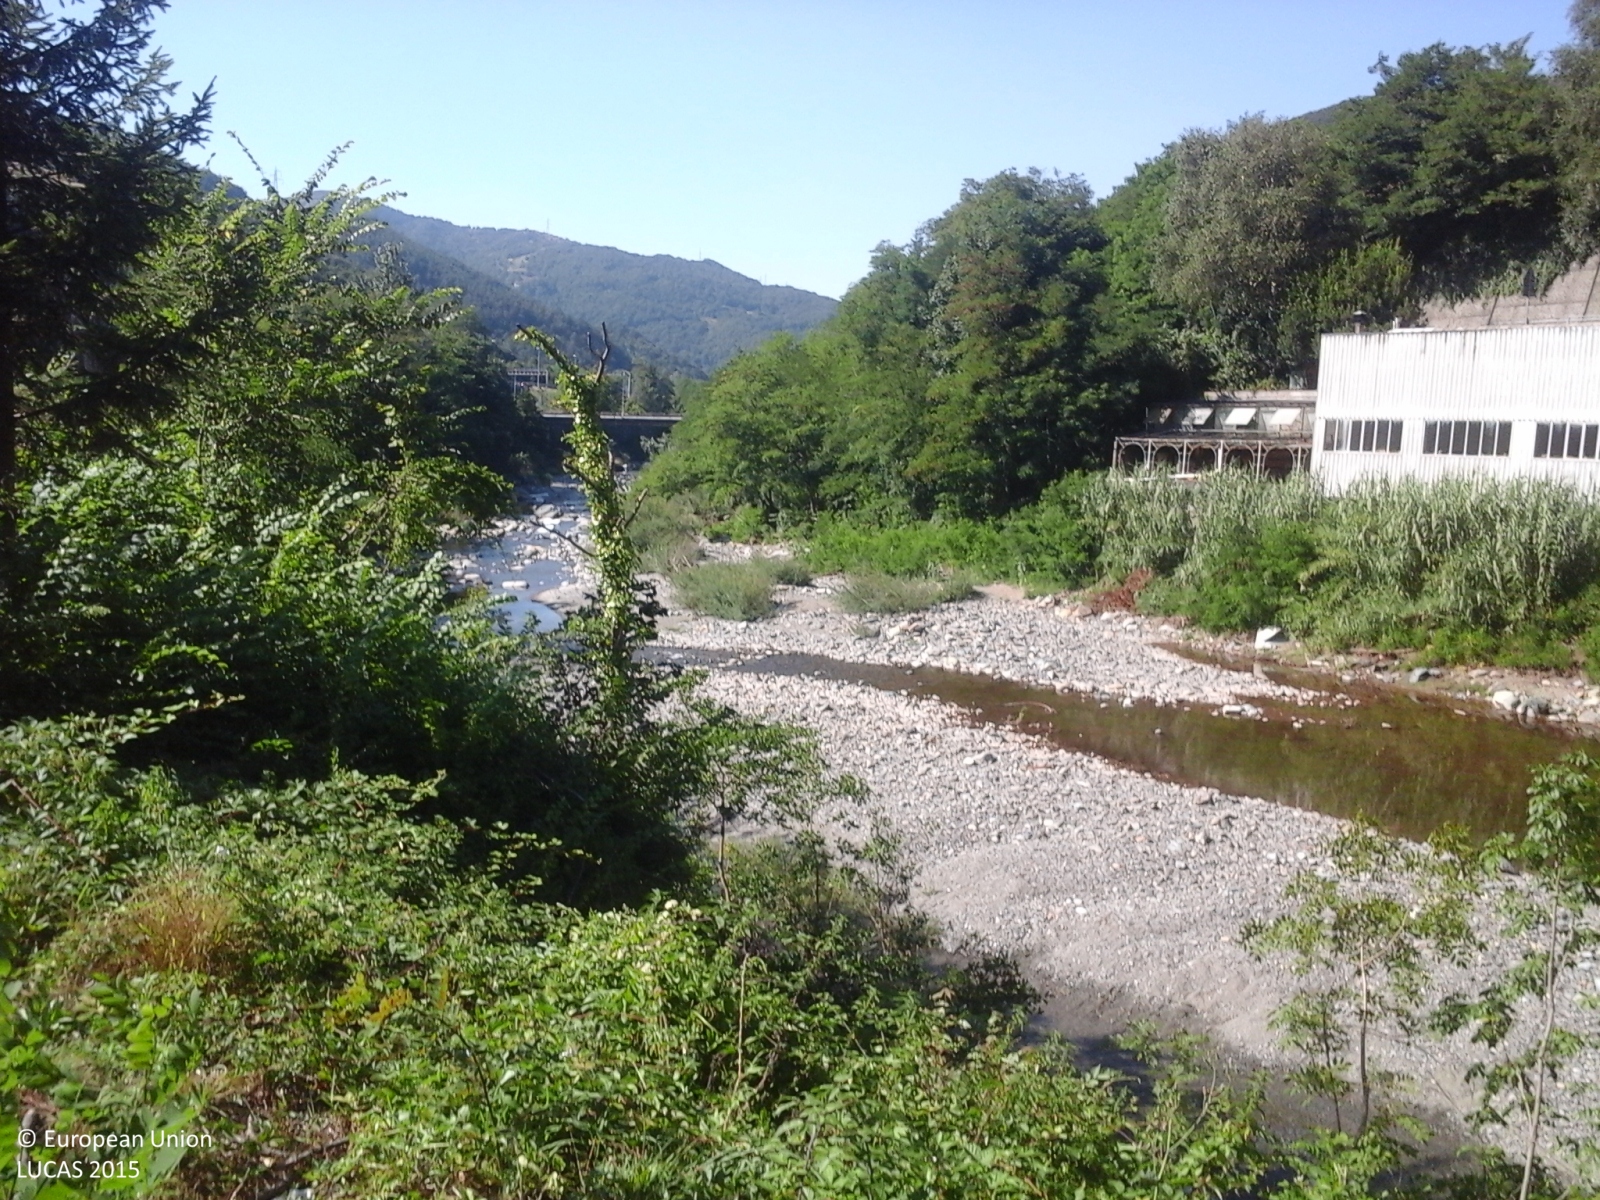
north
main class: Grassland
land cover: Grassland with sparse tree/shrub cover
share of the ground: > 75 %
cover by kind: herbaceous plants 85 %, shrubs 10 %, broadleaved forest trees 5 %
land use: Semi-natural and natural areas not in use
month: August
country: IT
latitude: 44.5048
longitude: 8.7073
